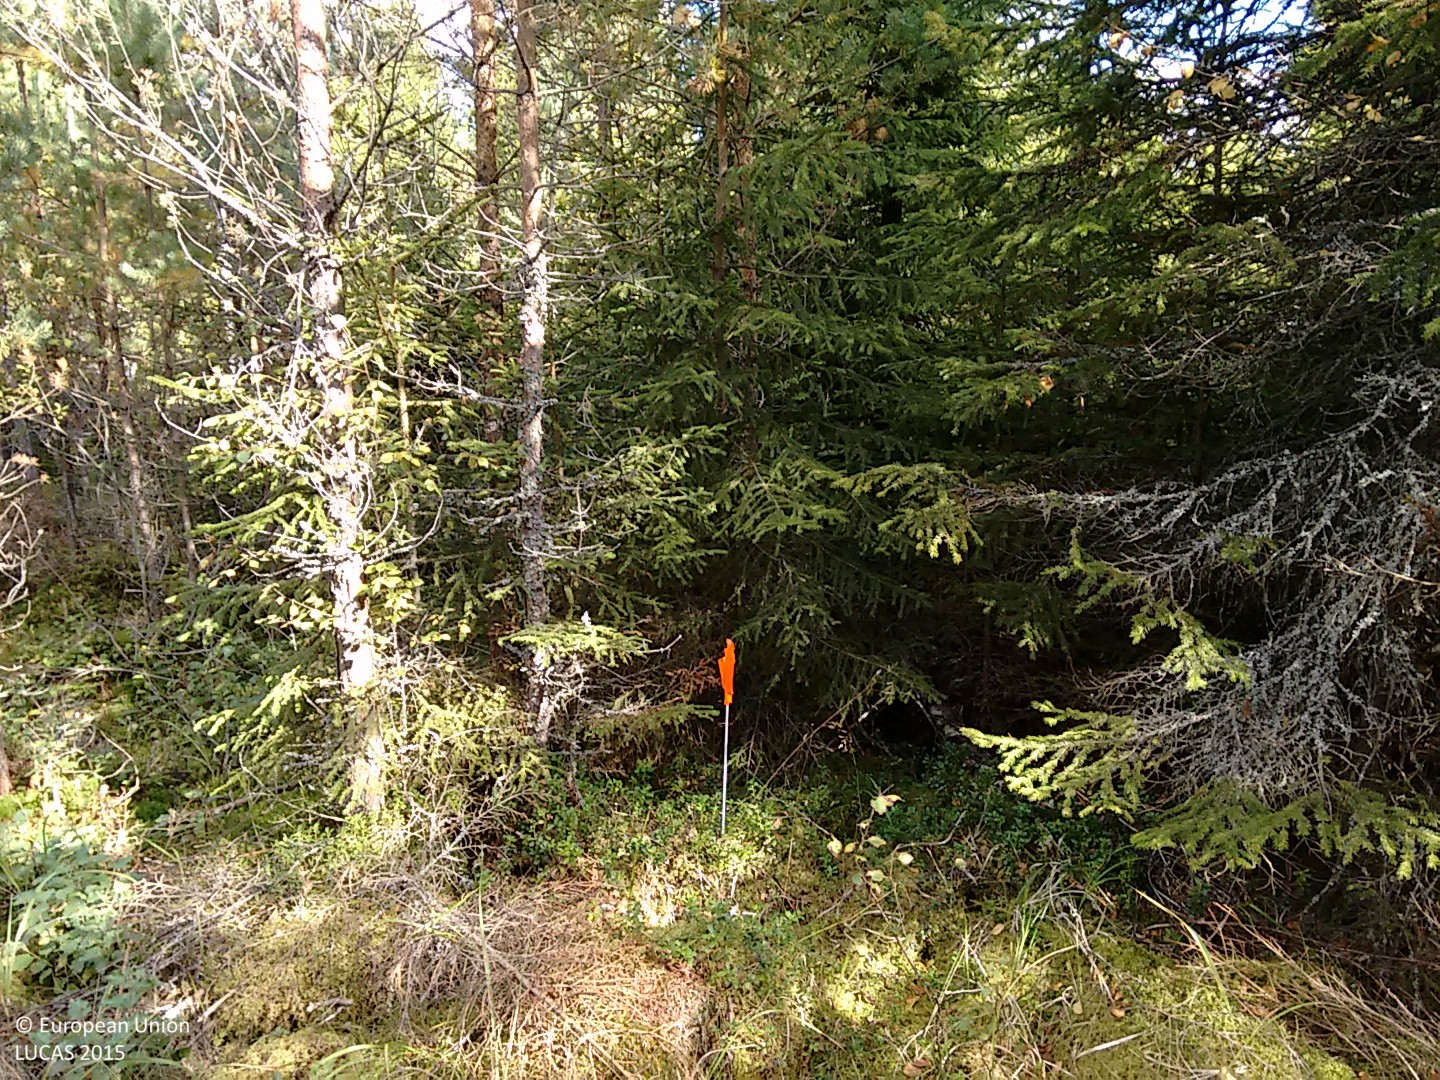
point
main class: Woodland
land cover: Spruce dominated coniferous woodland
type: hemiboreal forest and nemoral coniferous forest and mixed broadleaved-coniferous forest
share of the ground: > 75 %
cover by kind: coniferous forest trees 90 %, shrubs 5 %, lichens and mosses 5 %
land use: Forestry
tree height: > 5 m
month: September
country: FI
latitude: 60.9997
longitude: 21.7615
